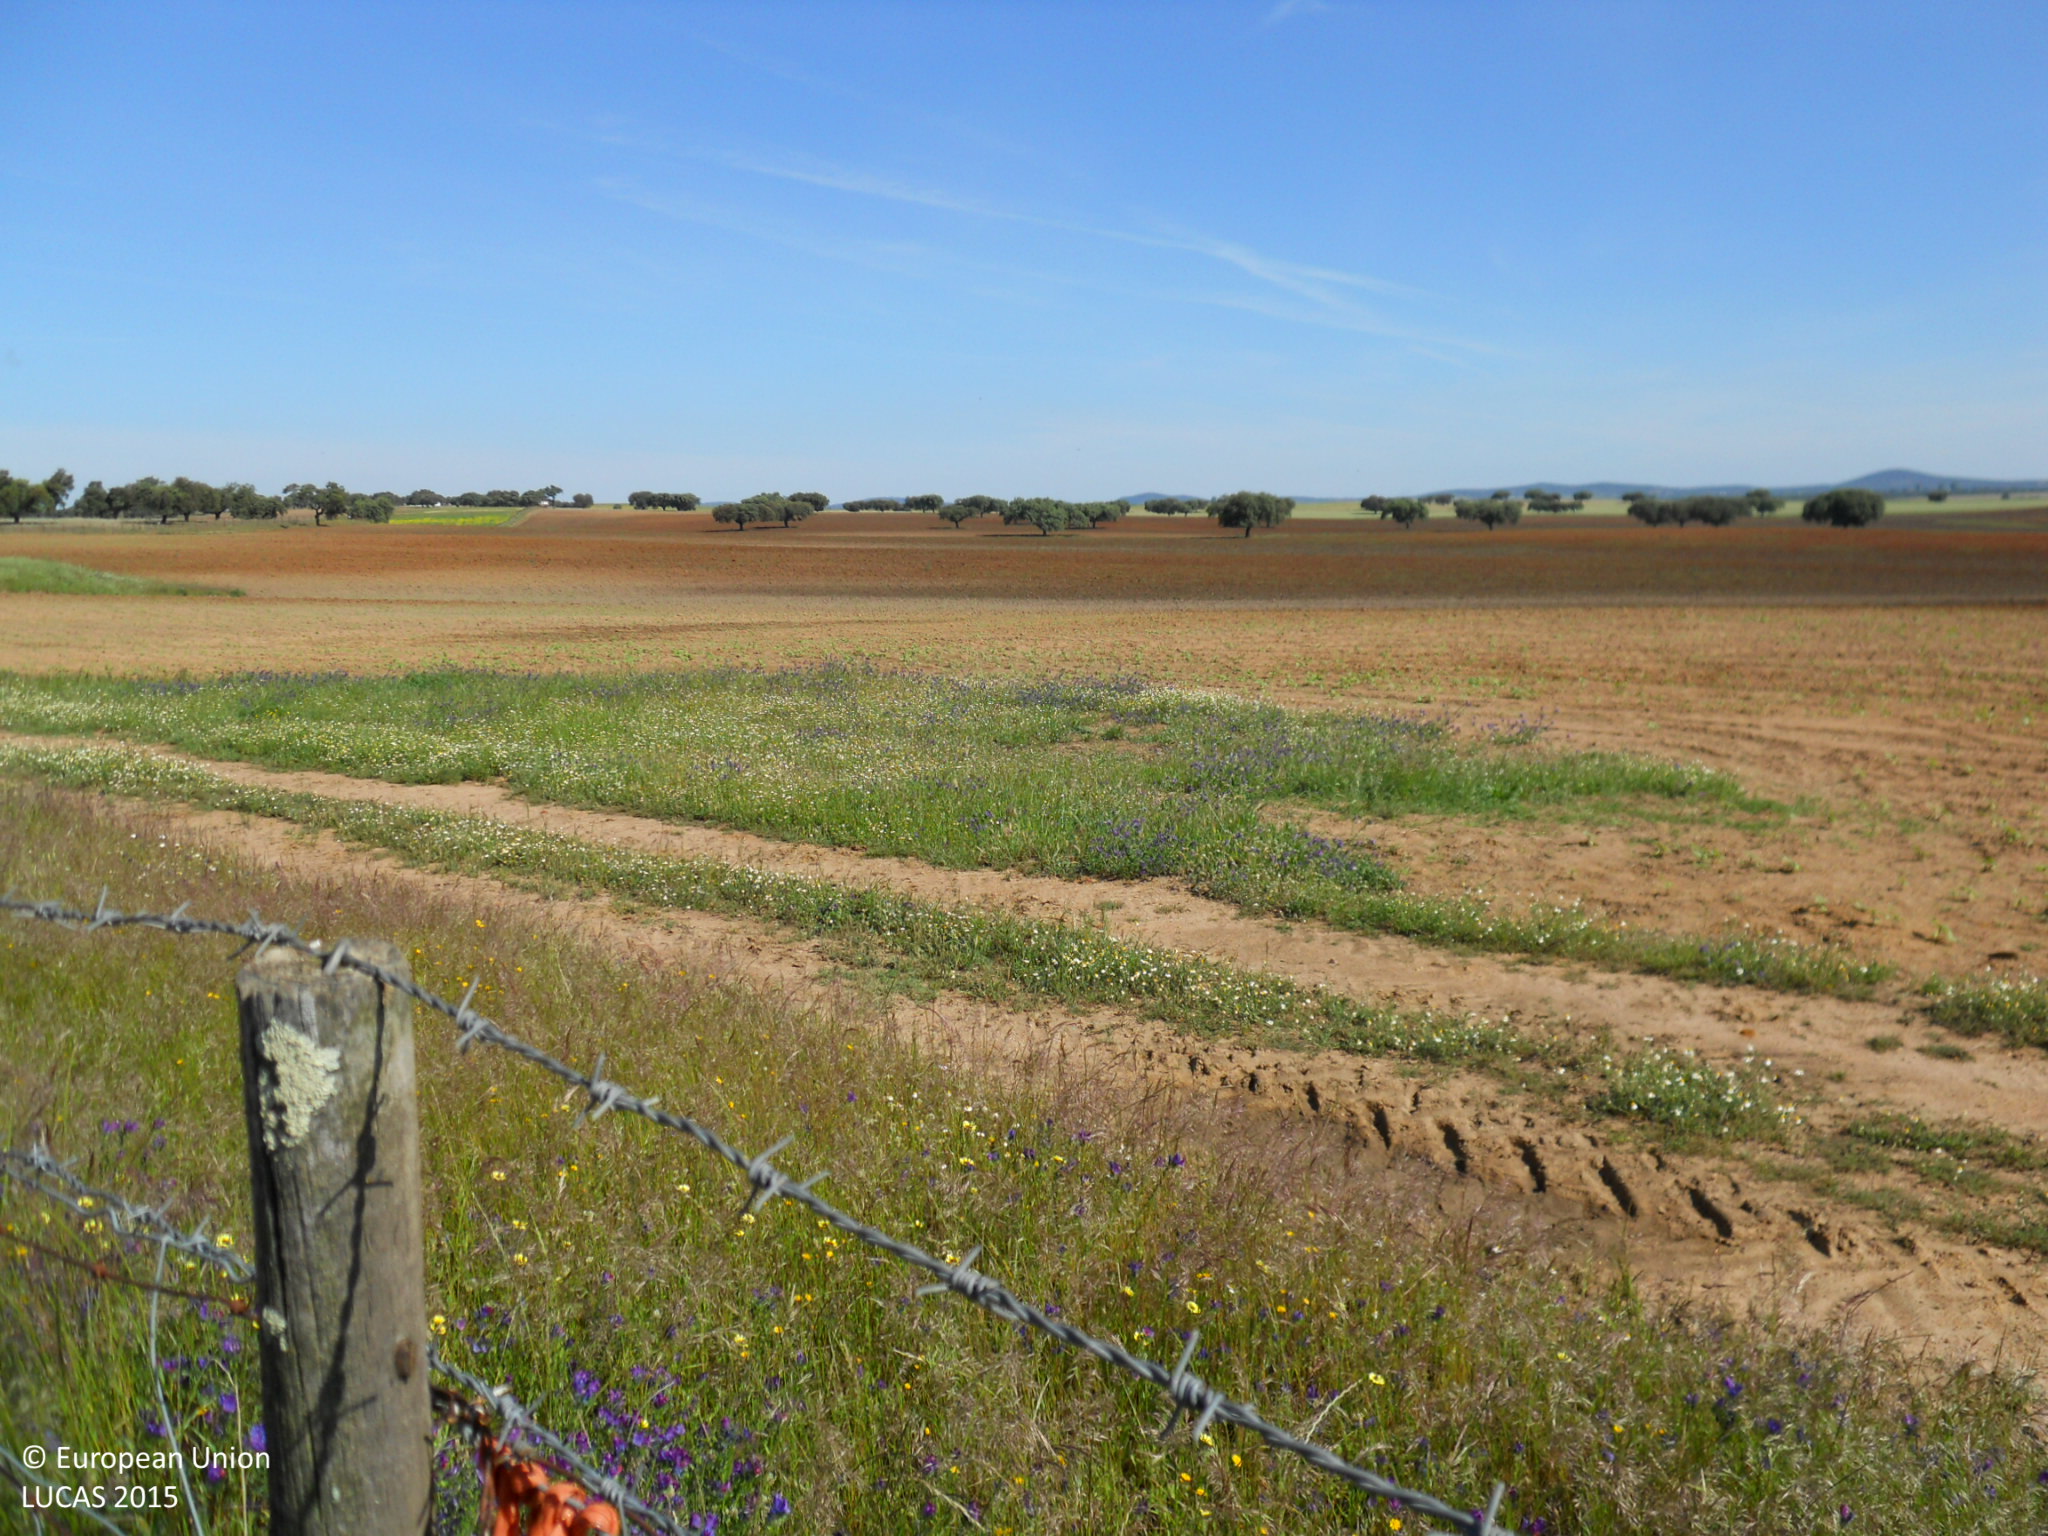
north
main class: Cropland
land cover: Sunflower
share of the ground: < 10 %
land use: Agriculture (excluding fallow land and kitchen gardens)
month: April
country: ES
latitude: 39.0407
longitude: -6.8337
